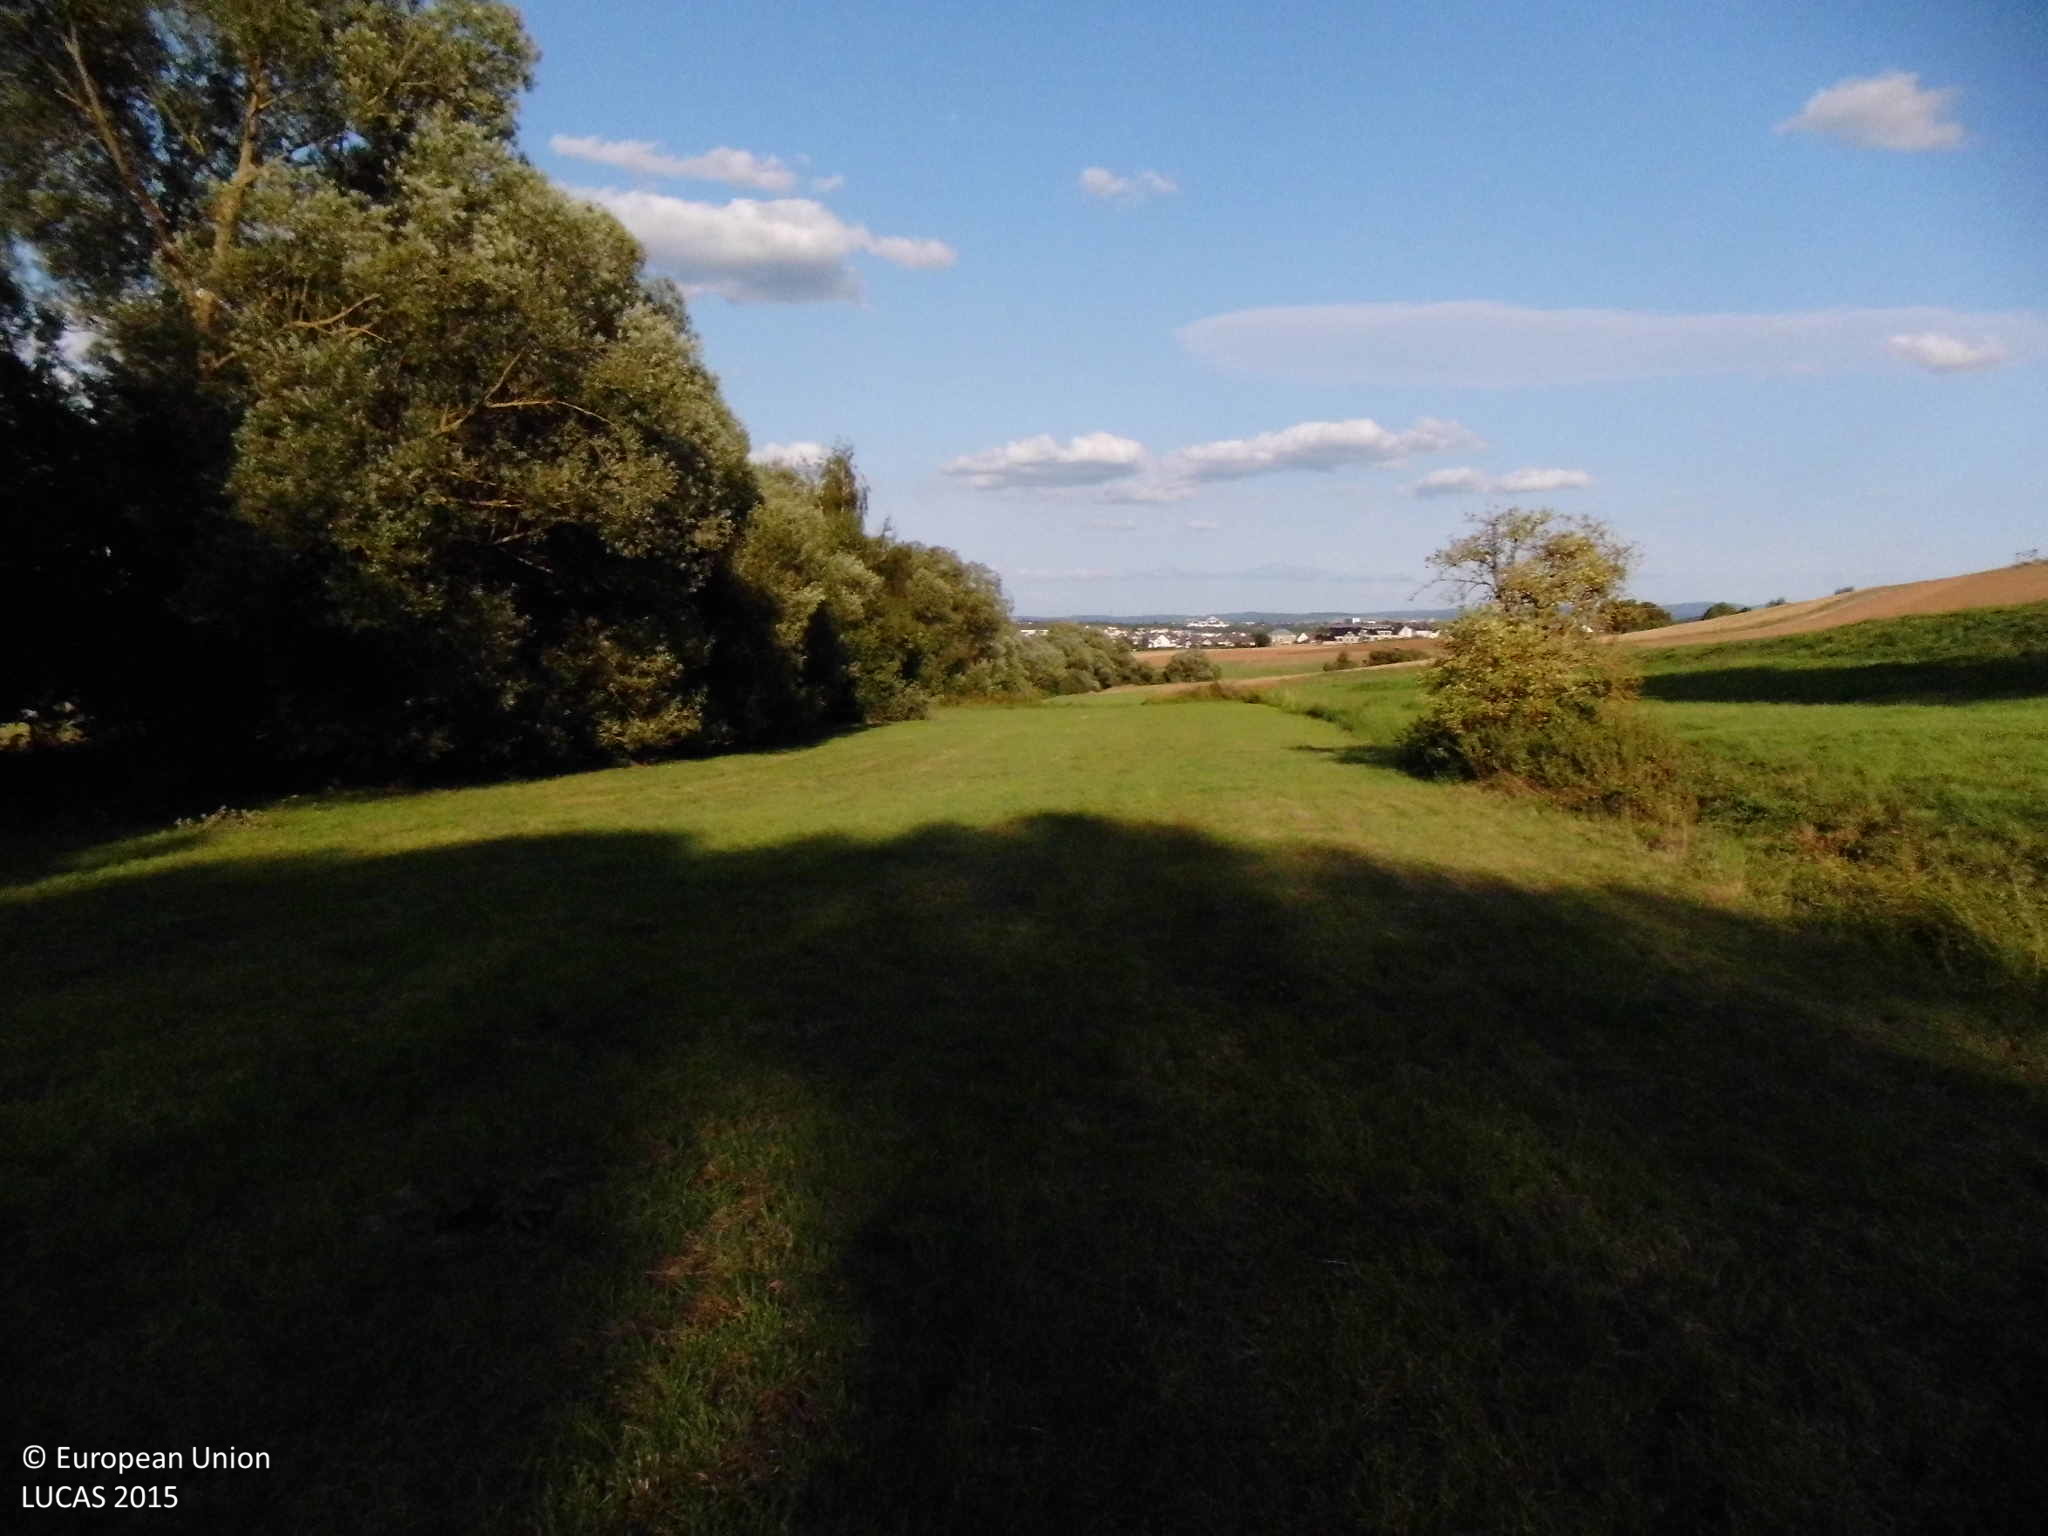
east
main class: Grassland
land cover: Grassland without tree/shrub cover
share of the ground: > 75 %
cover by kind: herbaceous plants 100 %
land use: Agriculture (excluding fallow land and kitchen gardens)
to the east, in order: Grassland without tree/shrub cover
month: August
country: DE
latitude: 50.4008
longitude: 8.0167
